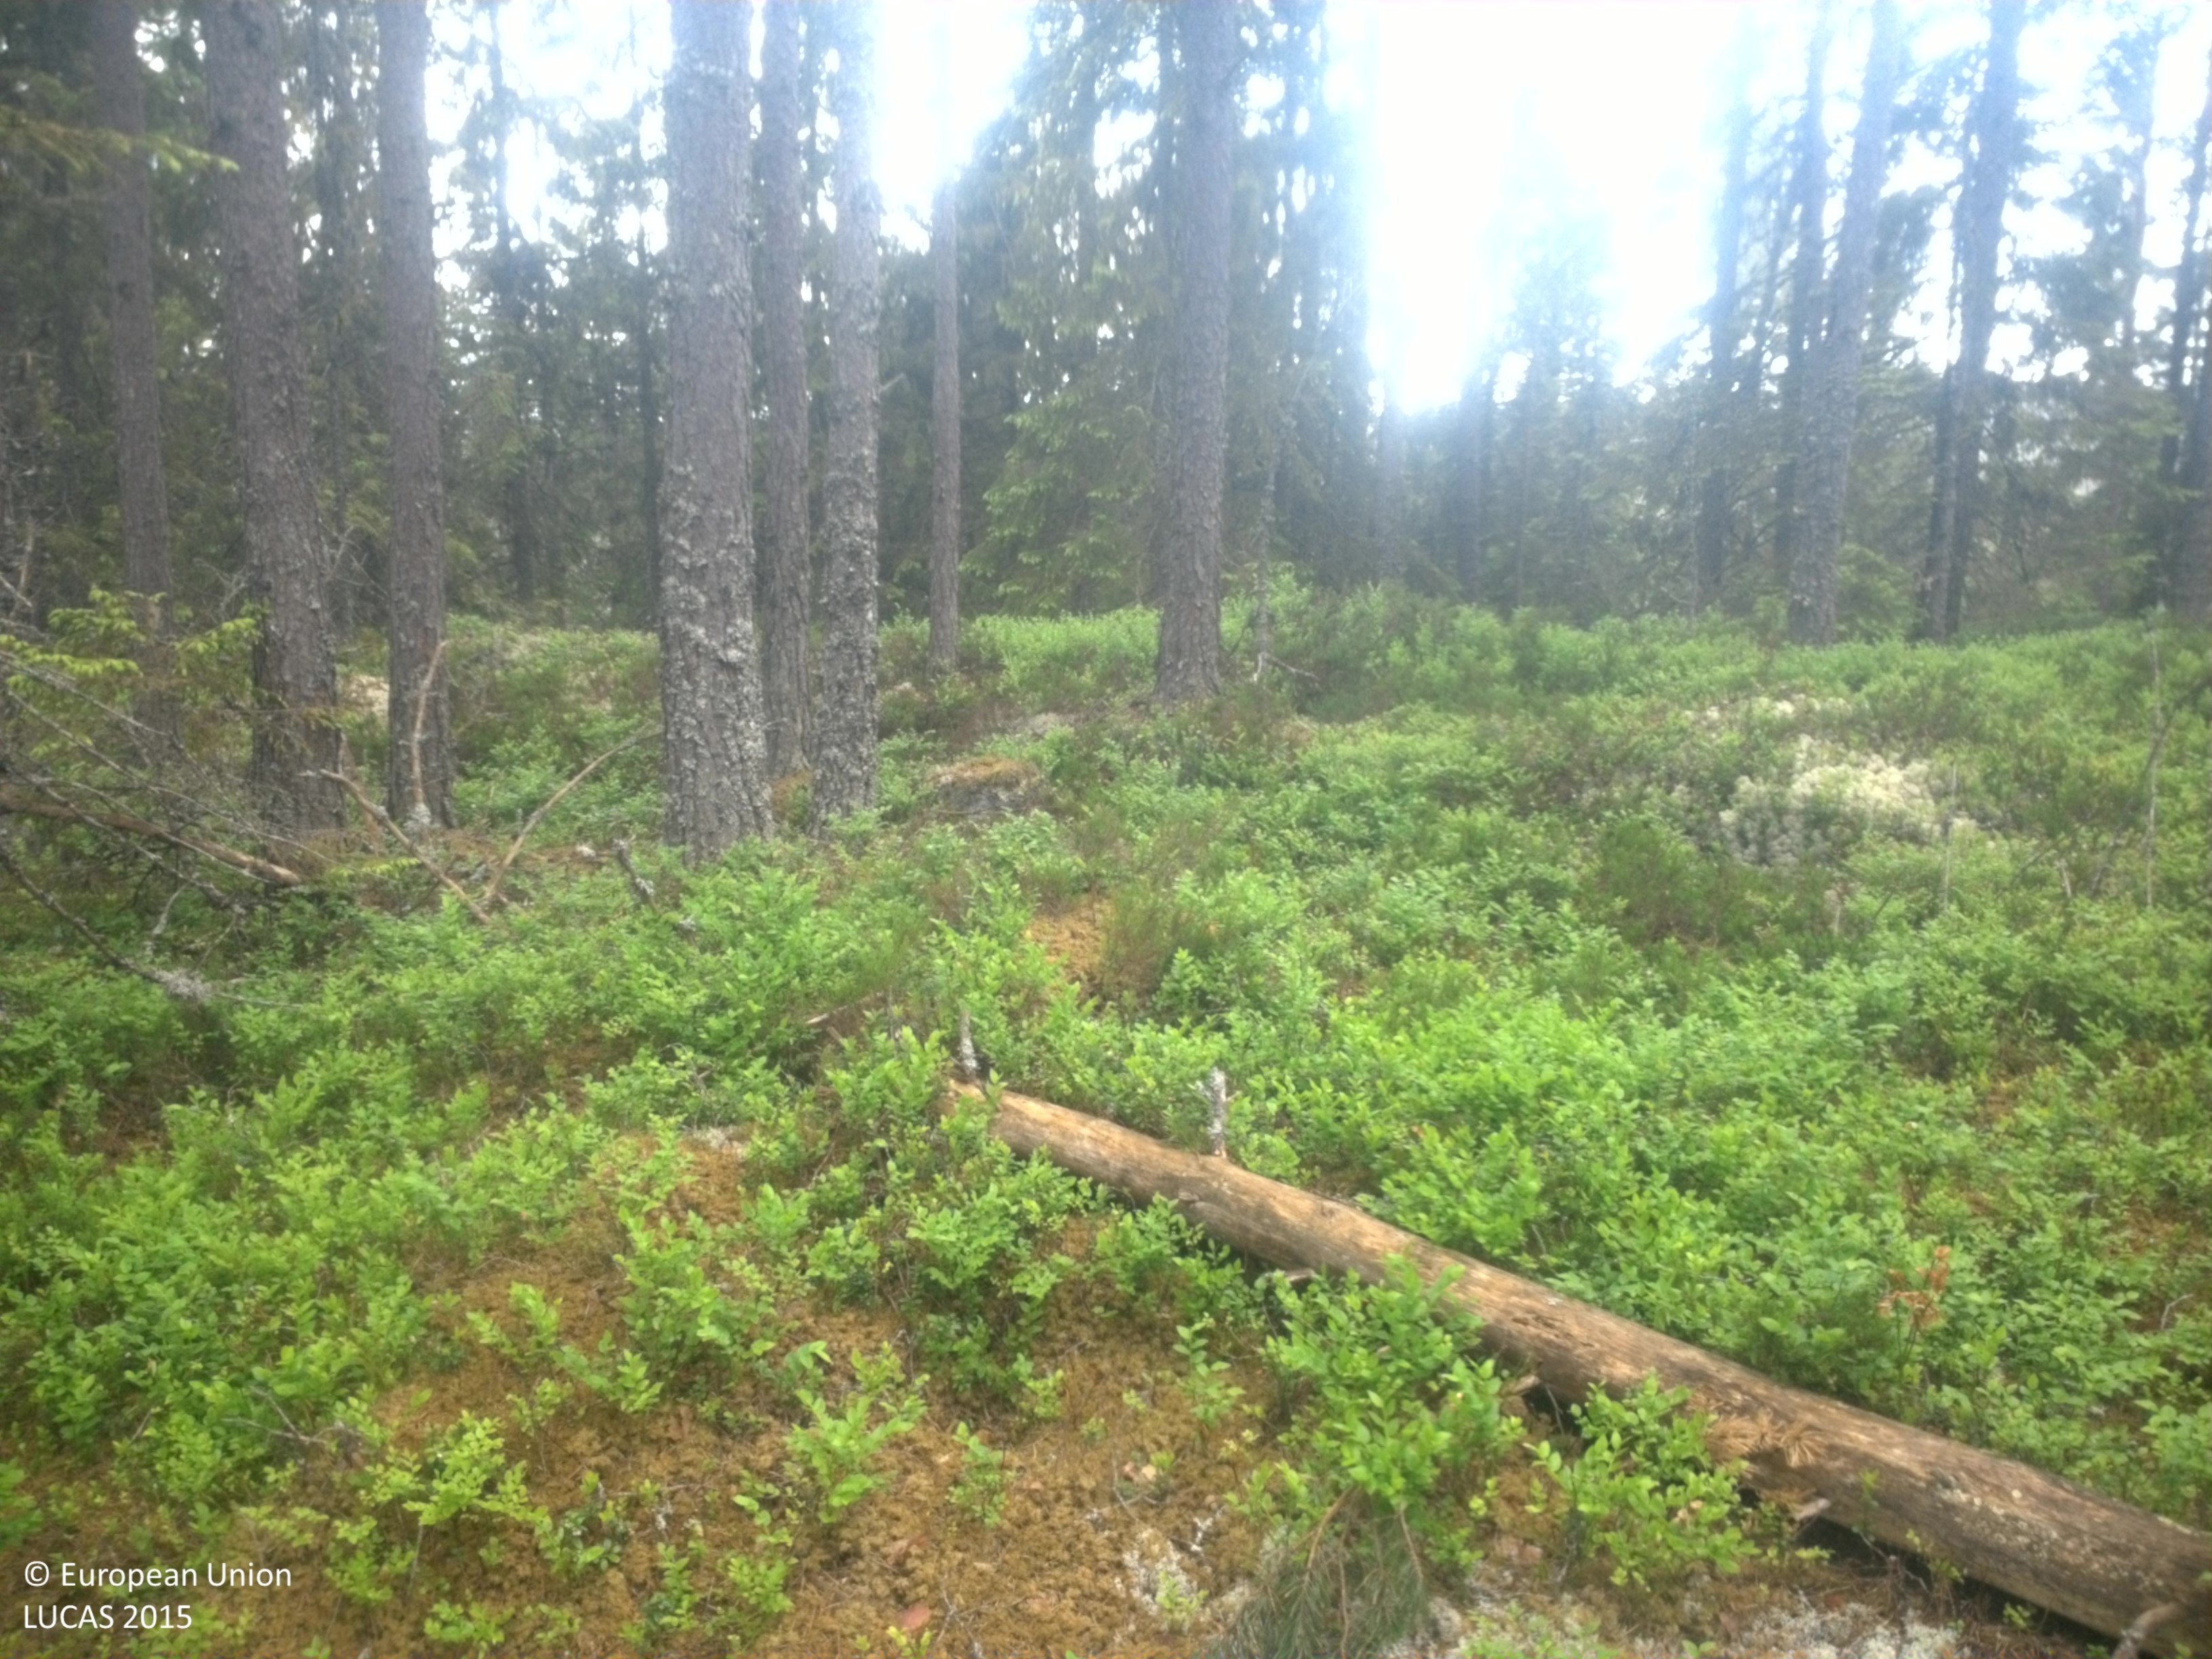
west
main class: Woodland
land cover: Other coniferous woodland
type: boreal forest
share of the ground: 50 - 75 %
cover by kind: coniferous forest trees 60 %, shrubs 20 %, herbaceous plants 10 %, lichens and mosses 5 %, consolidated bare surface 5 %
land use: Forestry
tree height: > 5 m
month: June
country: SE
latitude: 59.4815
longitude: 14.3871
